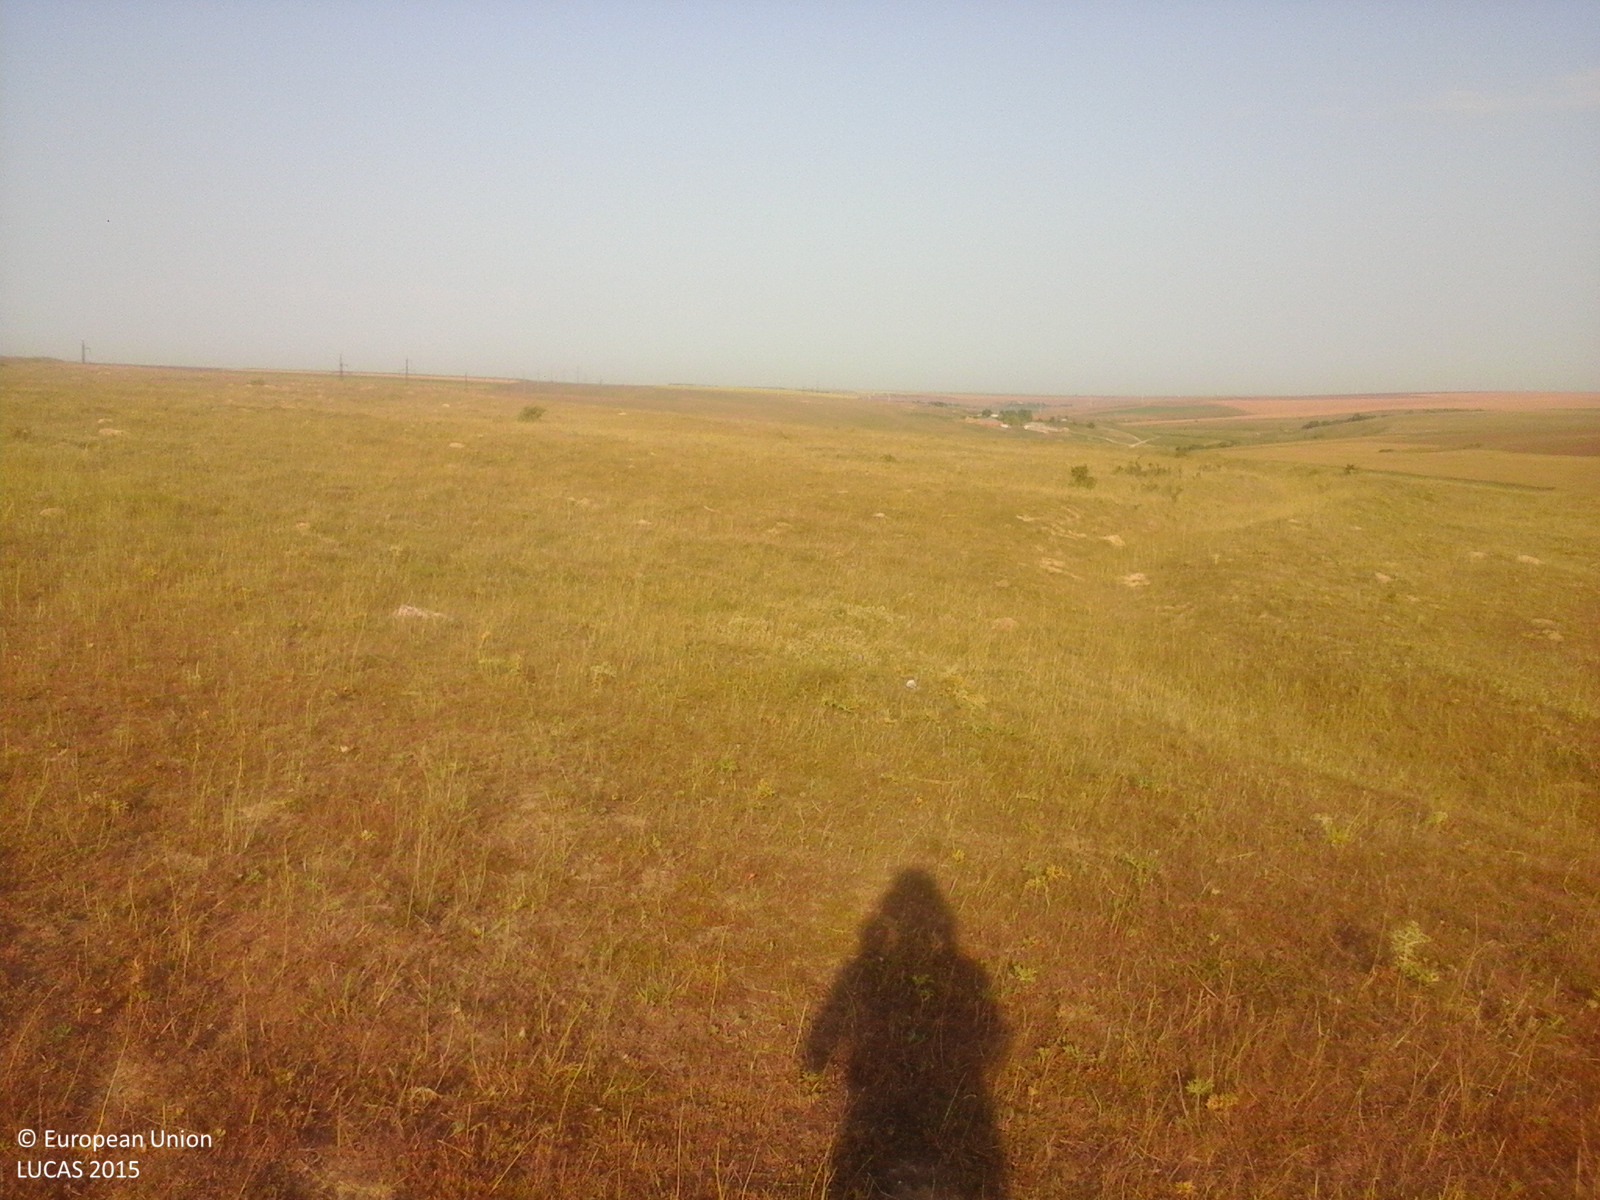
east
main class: Grassland
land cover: Grassland without tree/shrub cover
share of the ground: > 75 %
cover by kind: herbaceous plants 100 %
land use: Agriculture (excluding fallow land and kitchen gardens)
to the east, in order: Grassland without tree/shrub cover
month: August
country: RO
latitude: 44.0014
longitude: 28.0753
